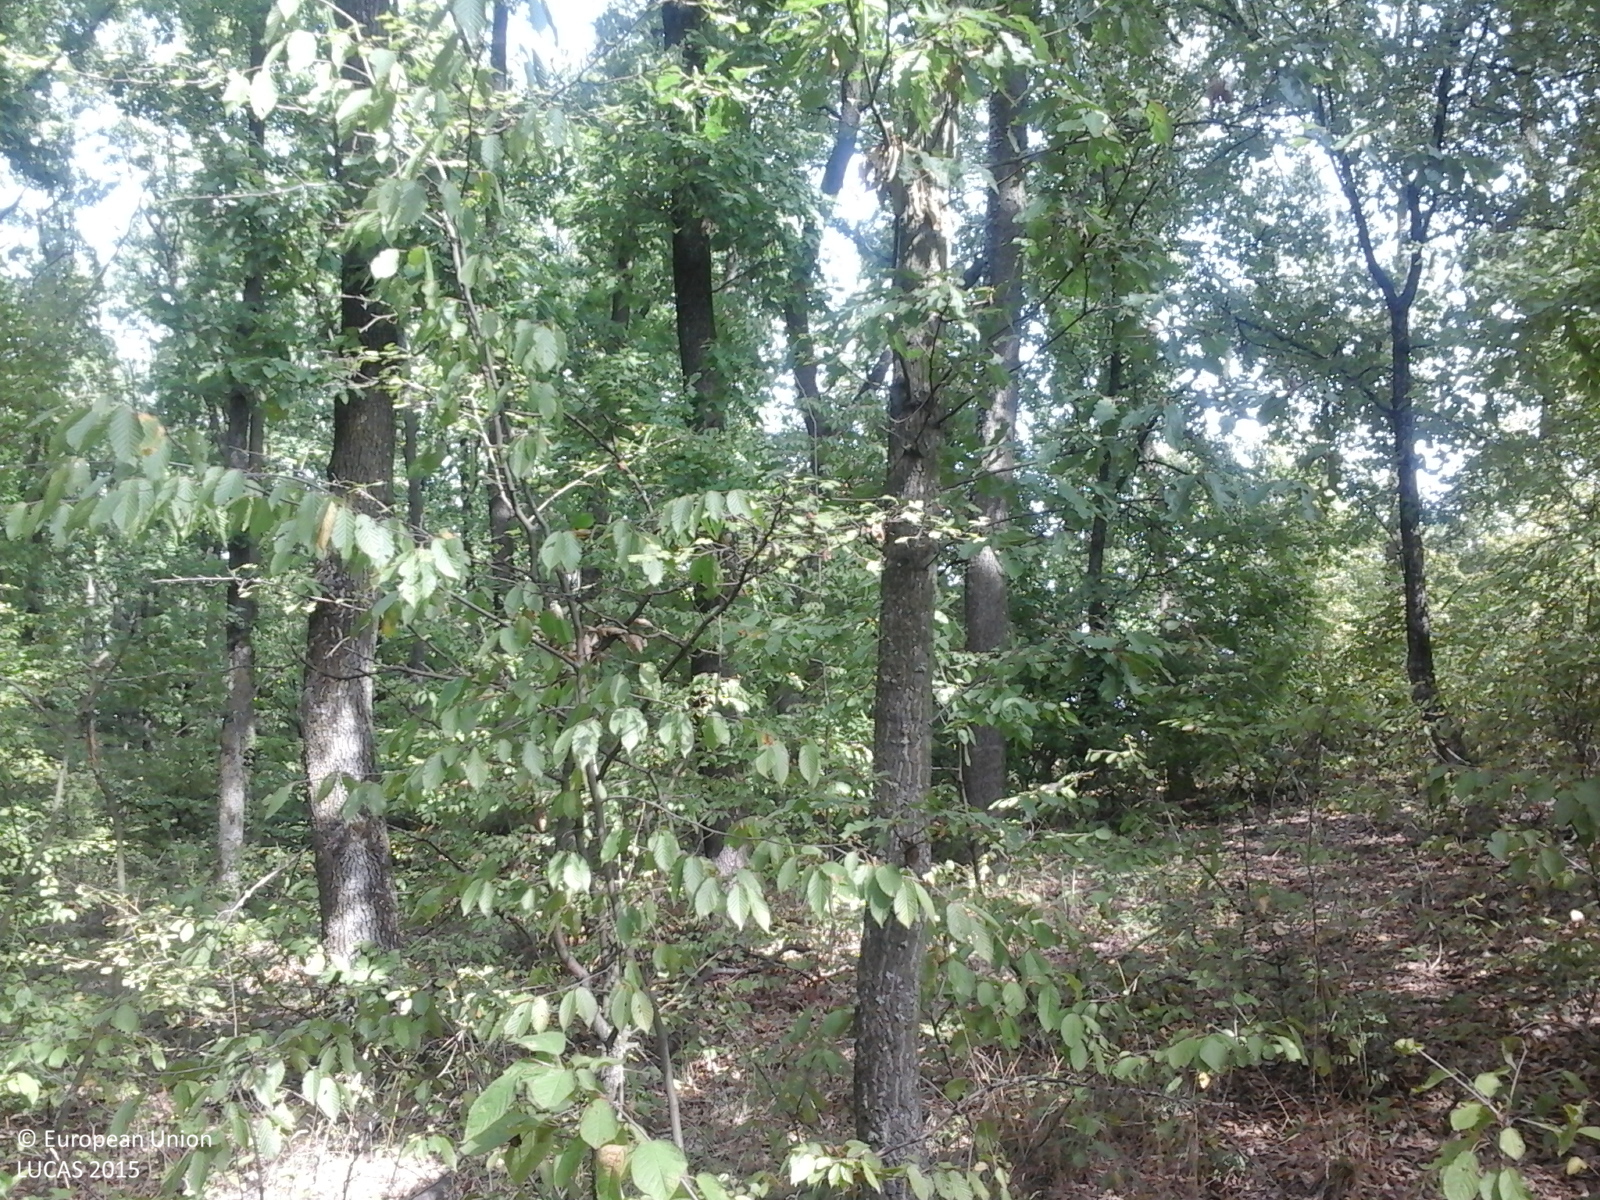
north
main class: Woodland
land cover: Broadleaved woodland
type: acidophilous oak and oak-birch forest
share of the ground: > 75 %
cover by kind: broadleaved forest trees 100 %
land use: Forestry
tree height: > 5 m
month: September
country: RO
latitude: 47.1261
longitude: 23.2627
